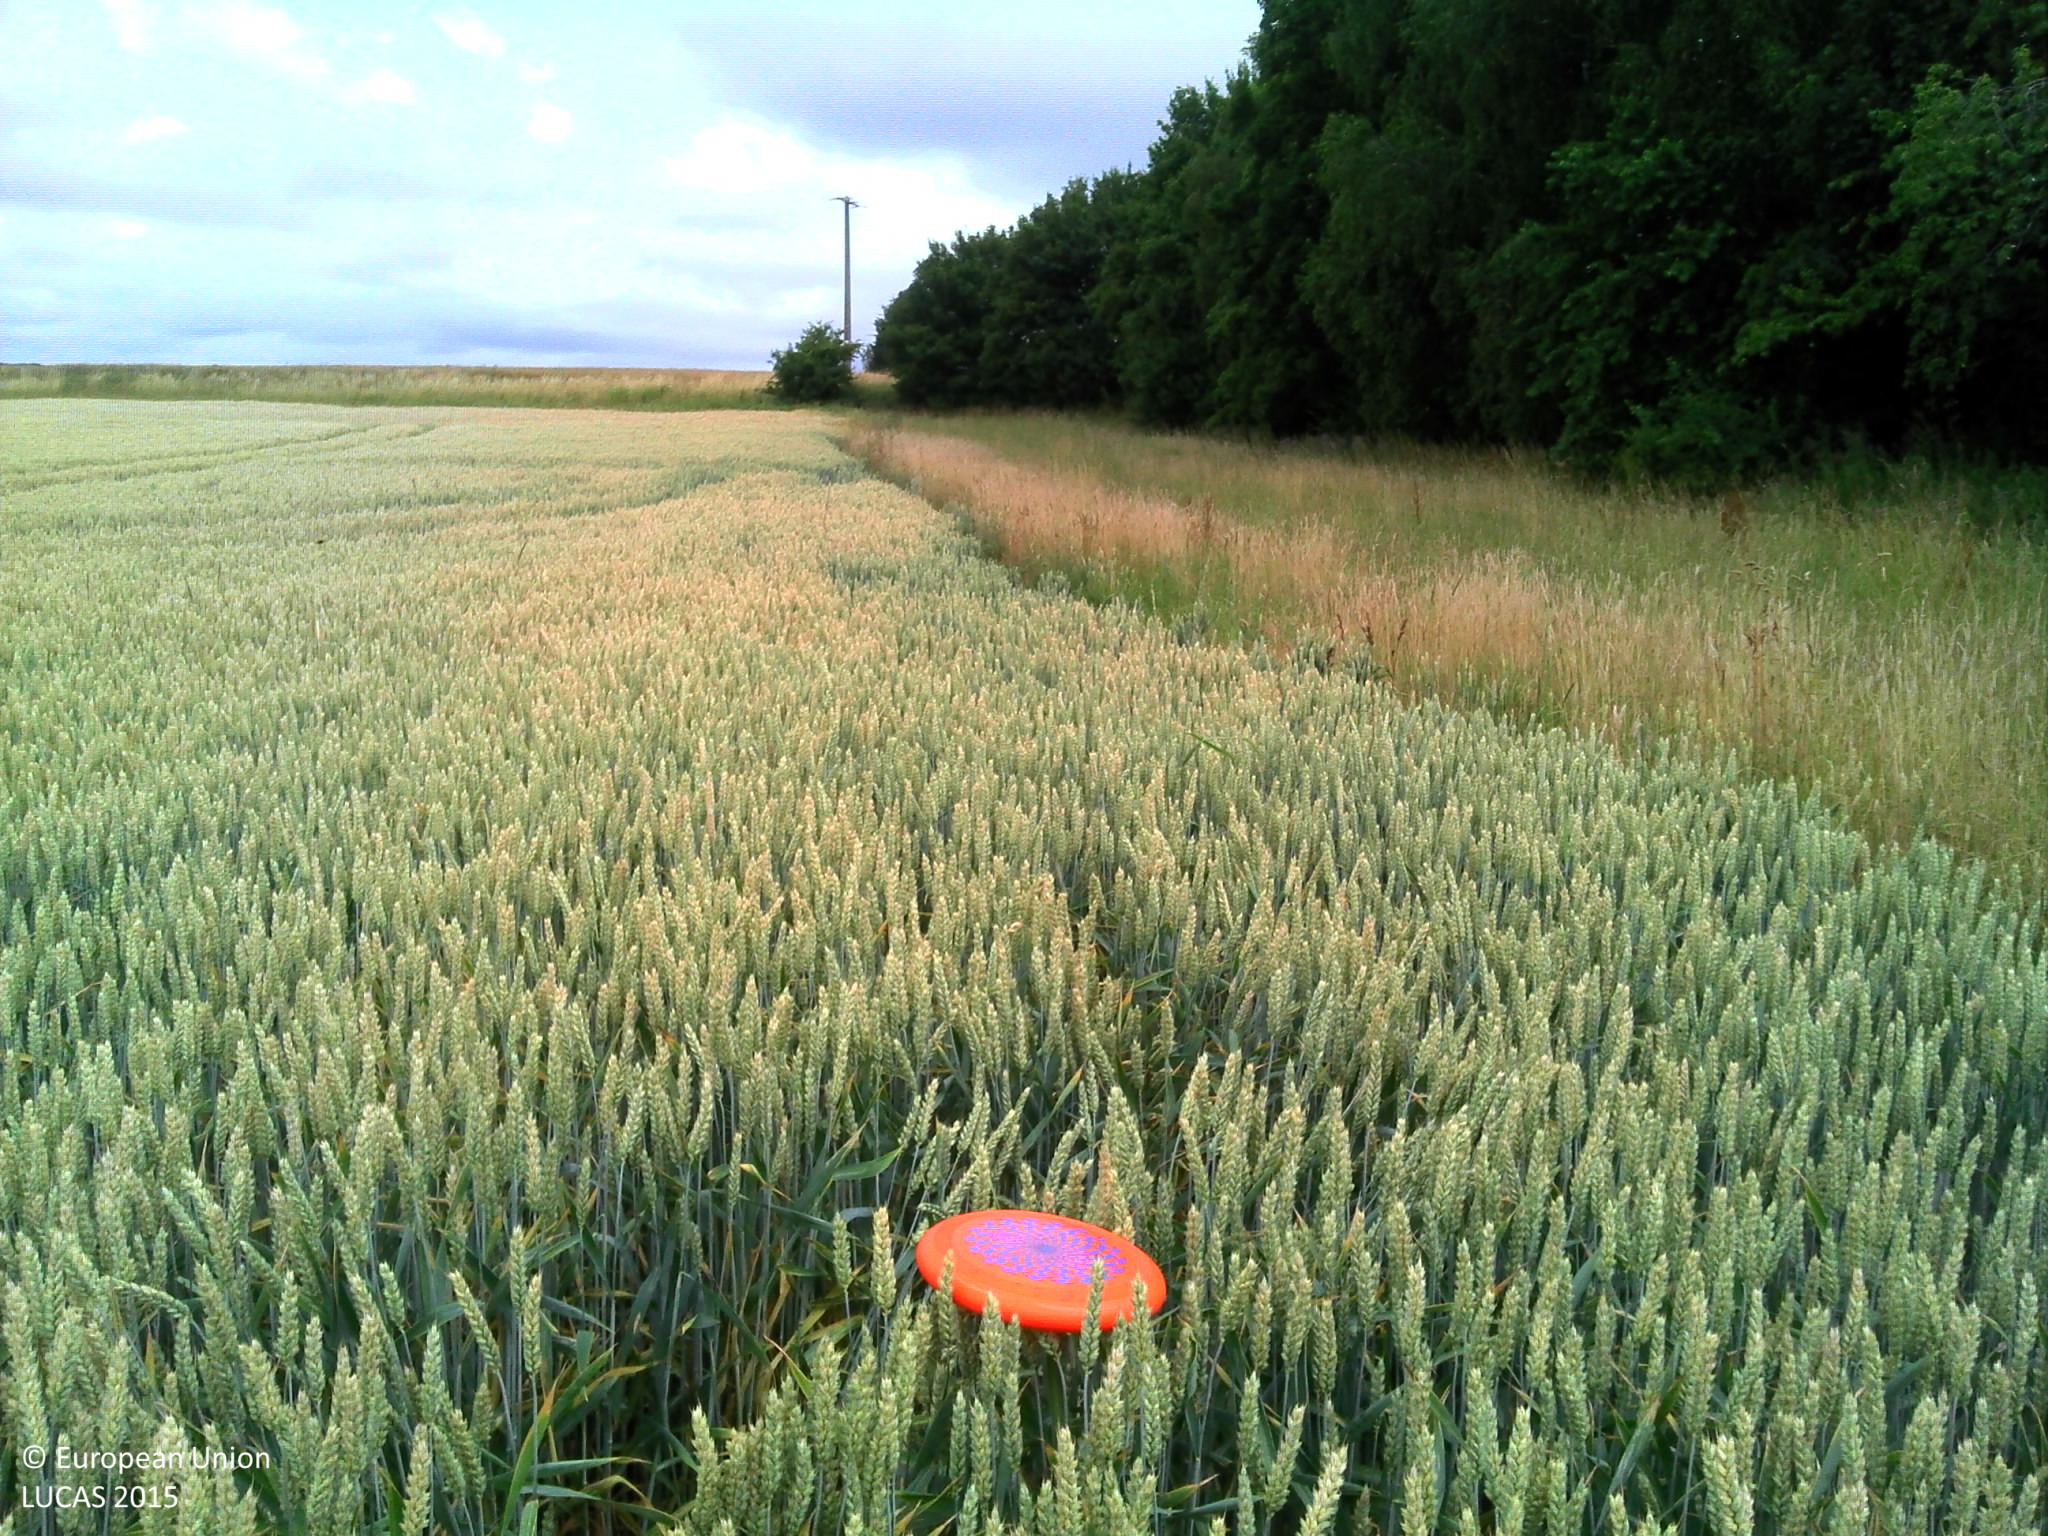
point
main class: Cropland
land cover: Common wheat
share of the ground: > 75 %
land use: Agriculture (excluding fallow land and kitchen gardens)
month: July
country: BE
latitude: 50.2146
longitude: 4.5166
